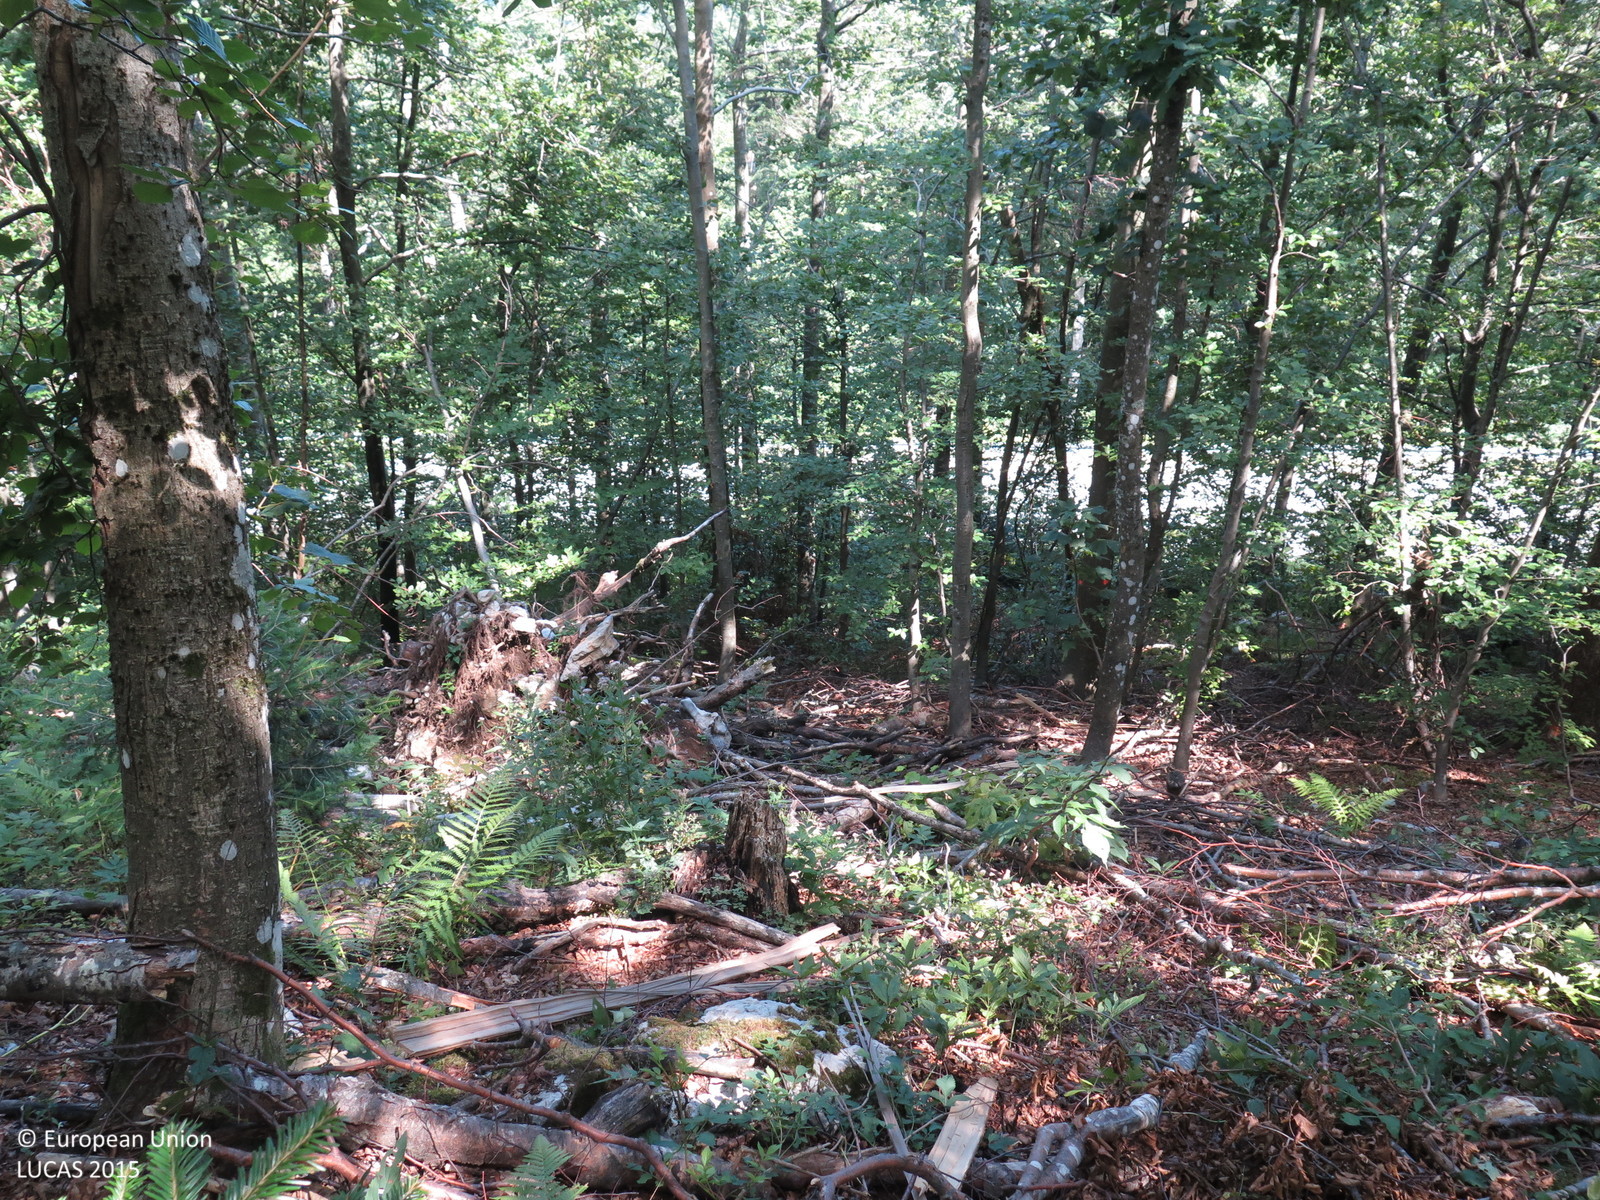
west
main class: Woodland
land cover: Broadleaved woodland
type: mountainous beech forest
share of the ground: > 75 %
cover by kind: broadleaved forest trees 75 %, coniferous forest trees 25 %
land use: Forestry
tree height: > 5 m
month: August
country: HR
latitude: 45.1707
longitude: 14.9698
